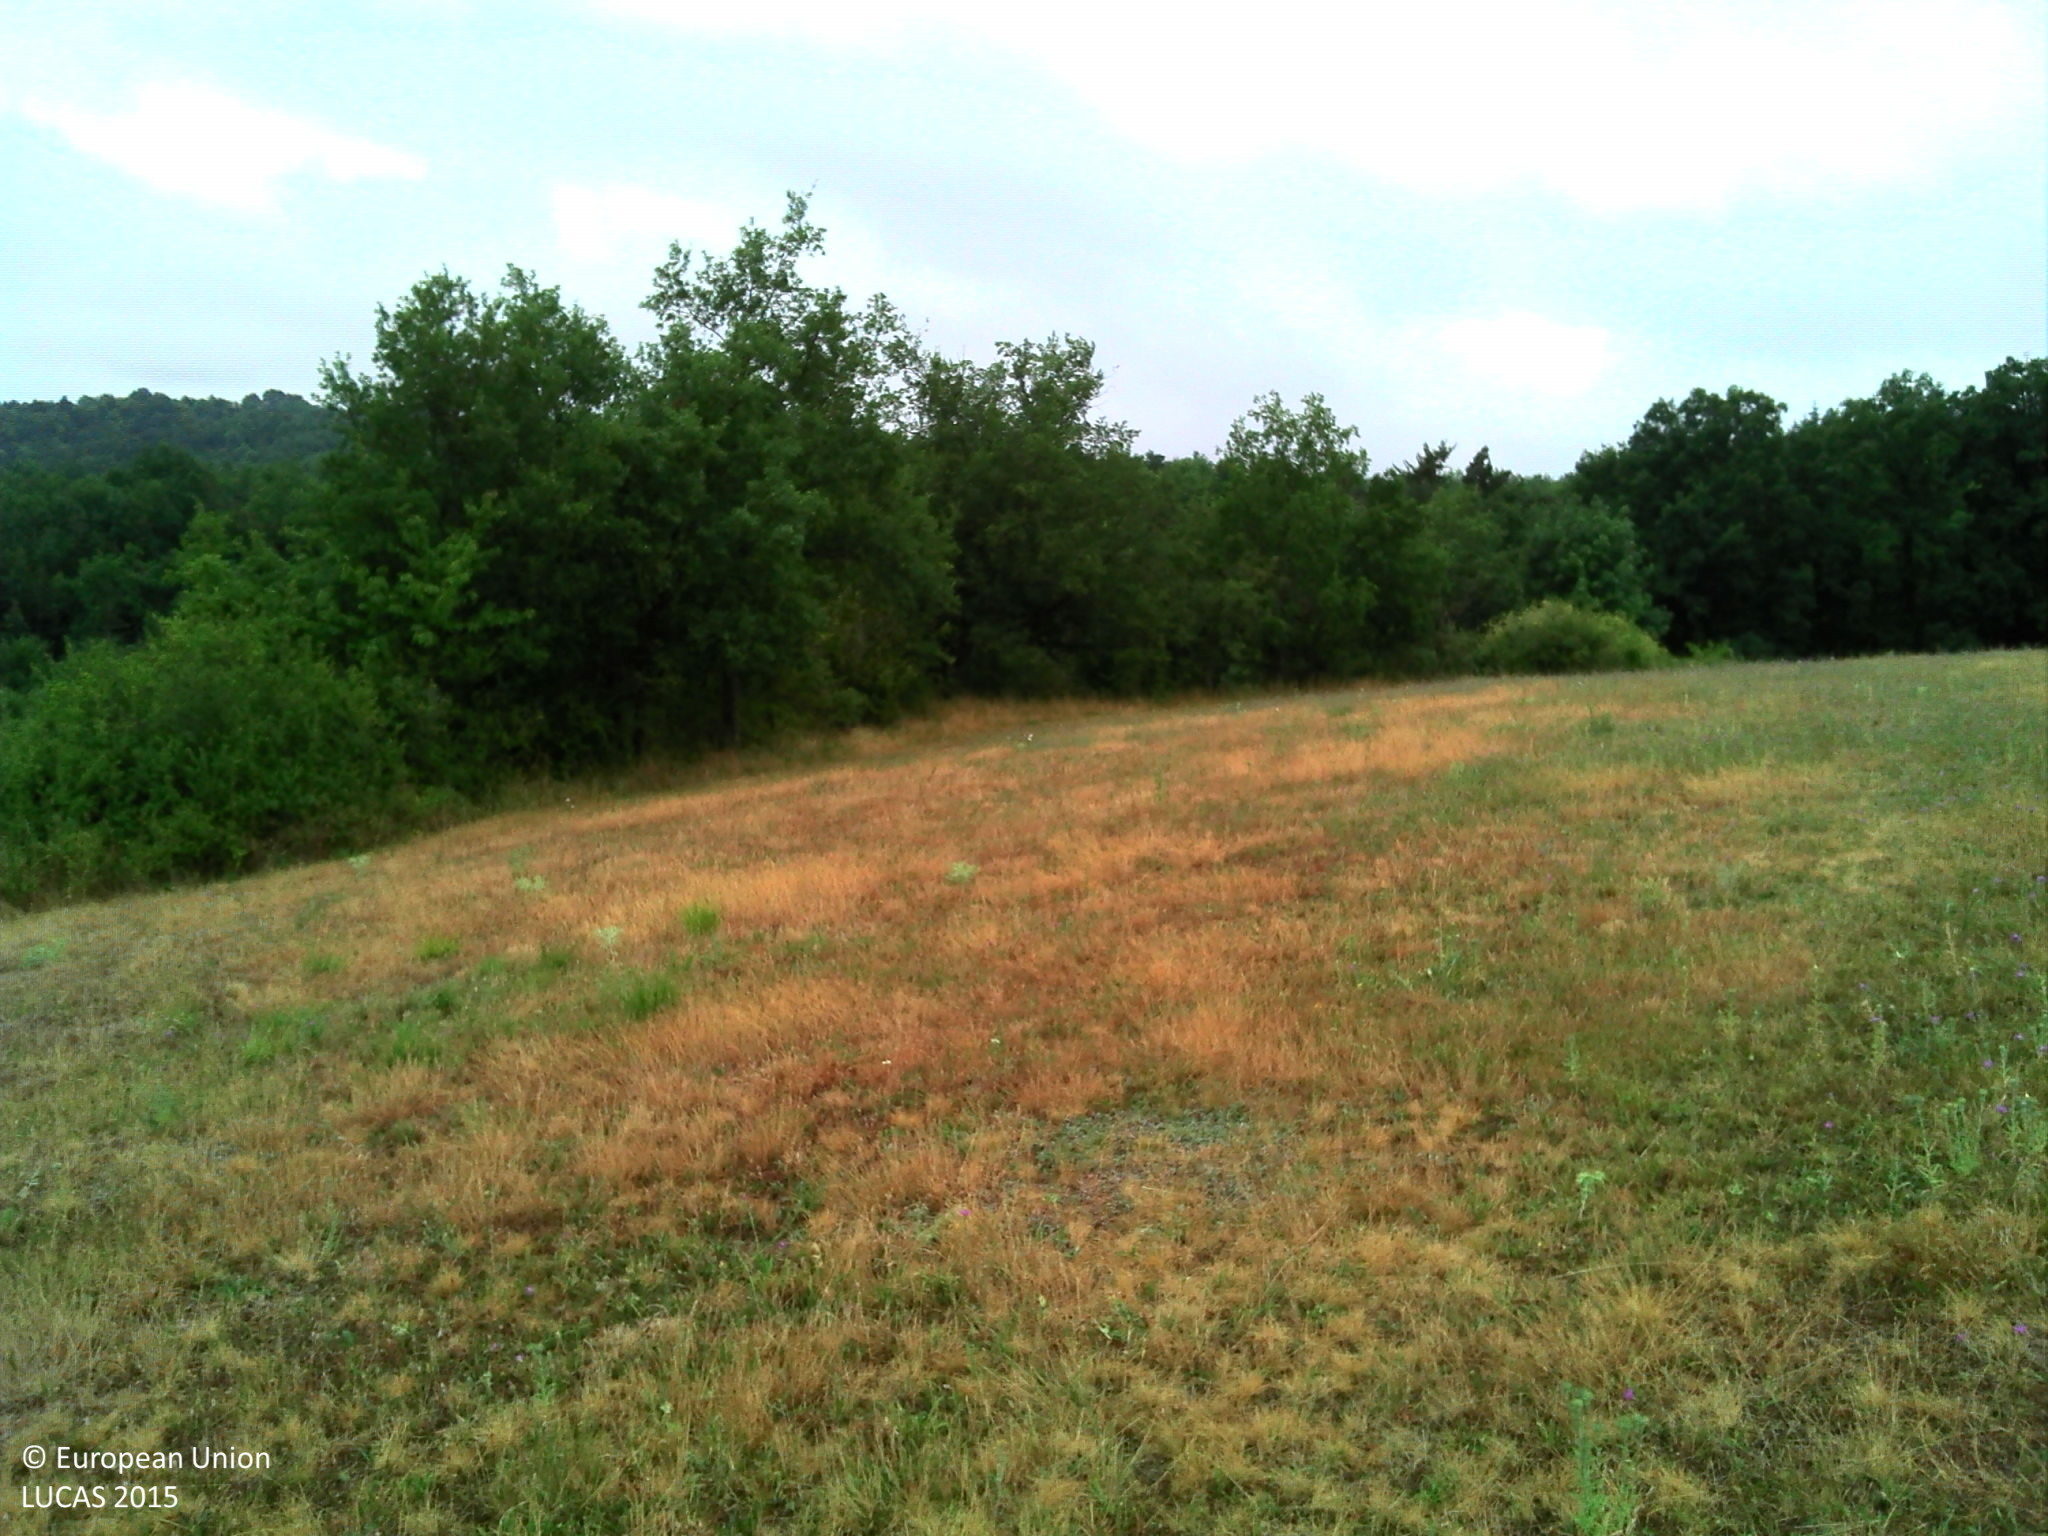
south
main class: Grassland
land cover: Grassland without tree/shrub cover
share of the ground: > 75 %
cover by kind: herbaceous plants 90 %, unconsolidated bare surface 10 %
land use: Agriculture (excluding fallow land and kitchen gardens)
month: August
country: FR
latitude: 45.4856
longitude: 4.1306
